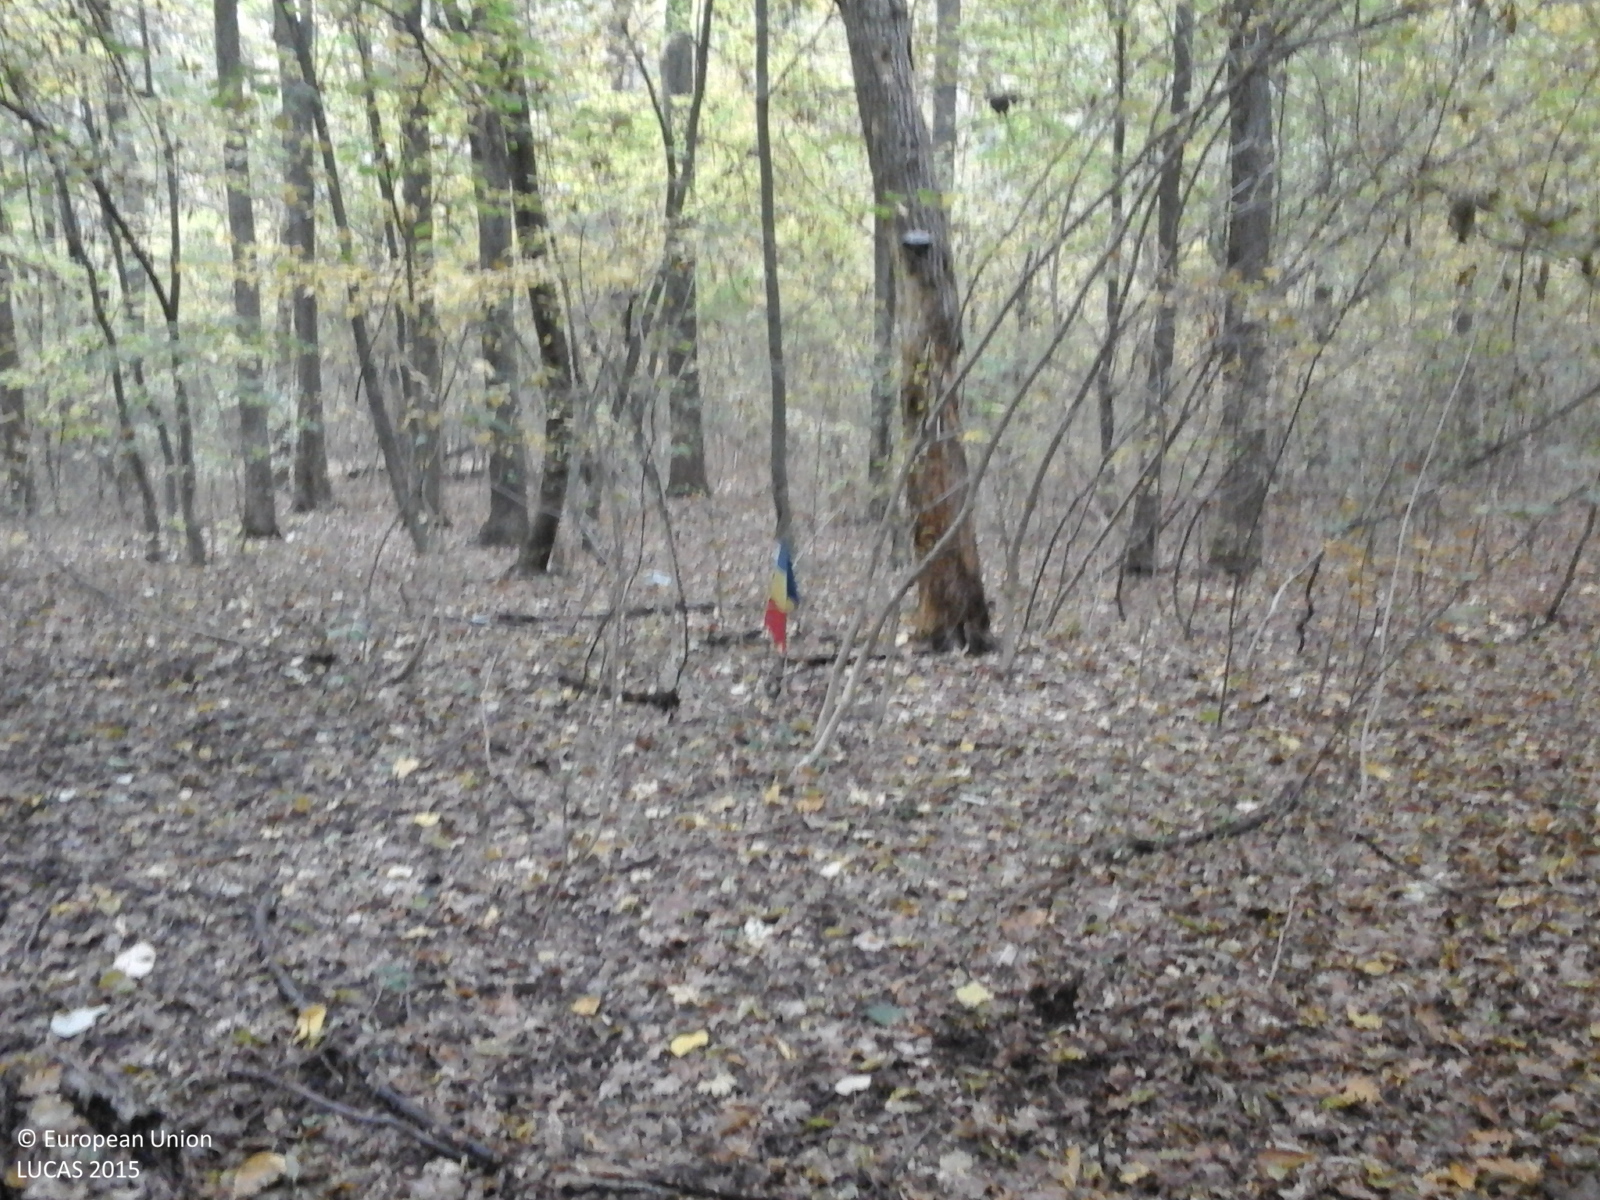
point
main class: Woodland
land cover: Broadleaved woodland
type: beech forest
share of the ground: > 75 %
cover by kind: broadleaved forest trees 100 %
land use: Forestry
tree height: > 5 m
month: October
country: RO
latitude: 44.7287
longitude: 26.0282
